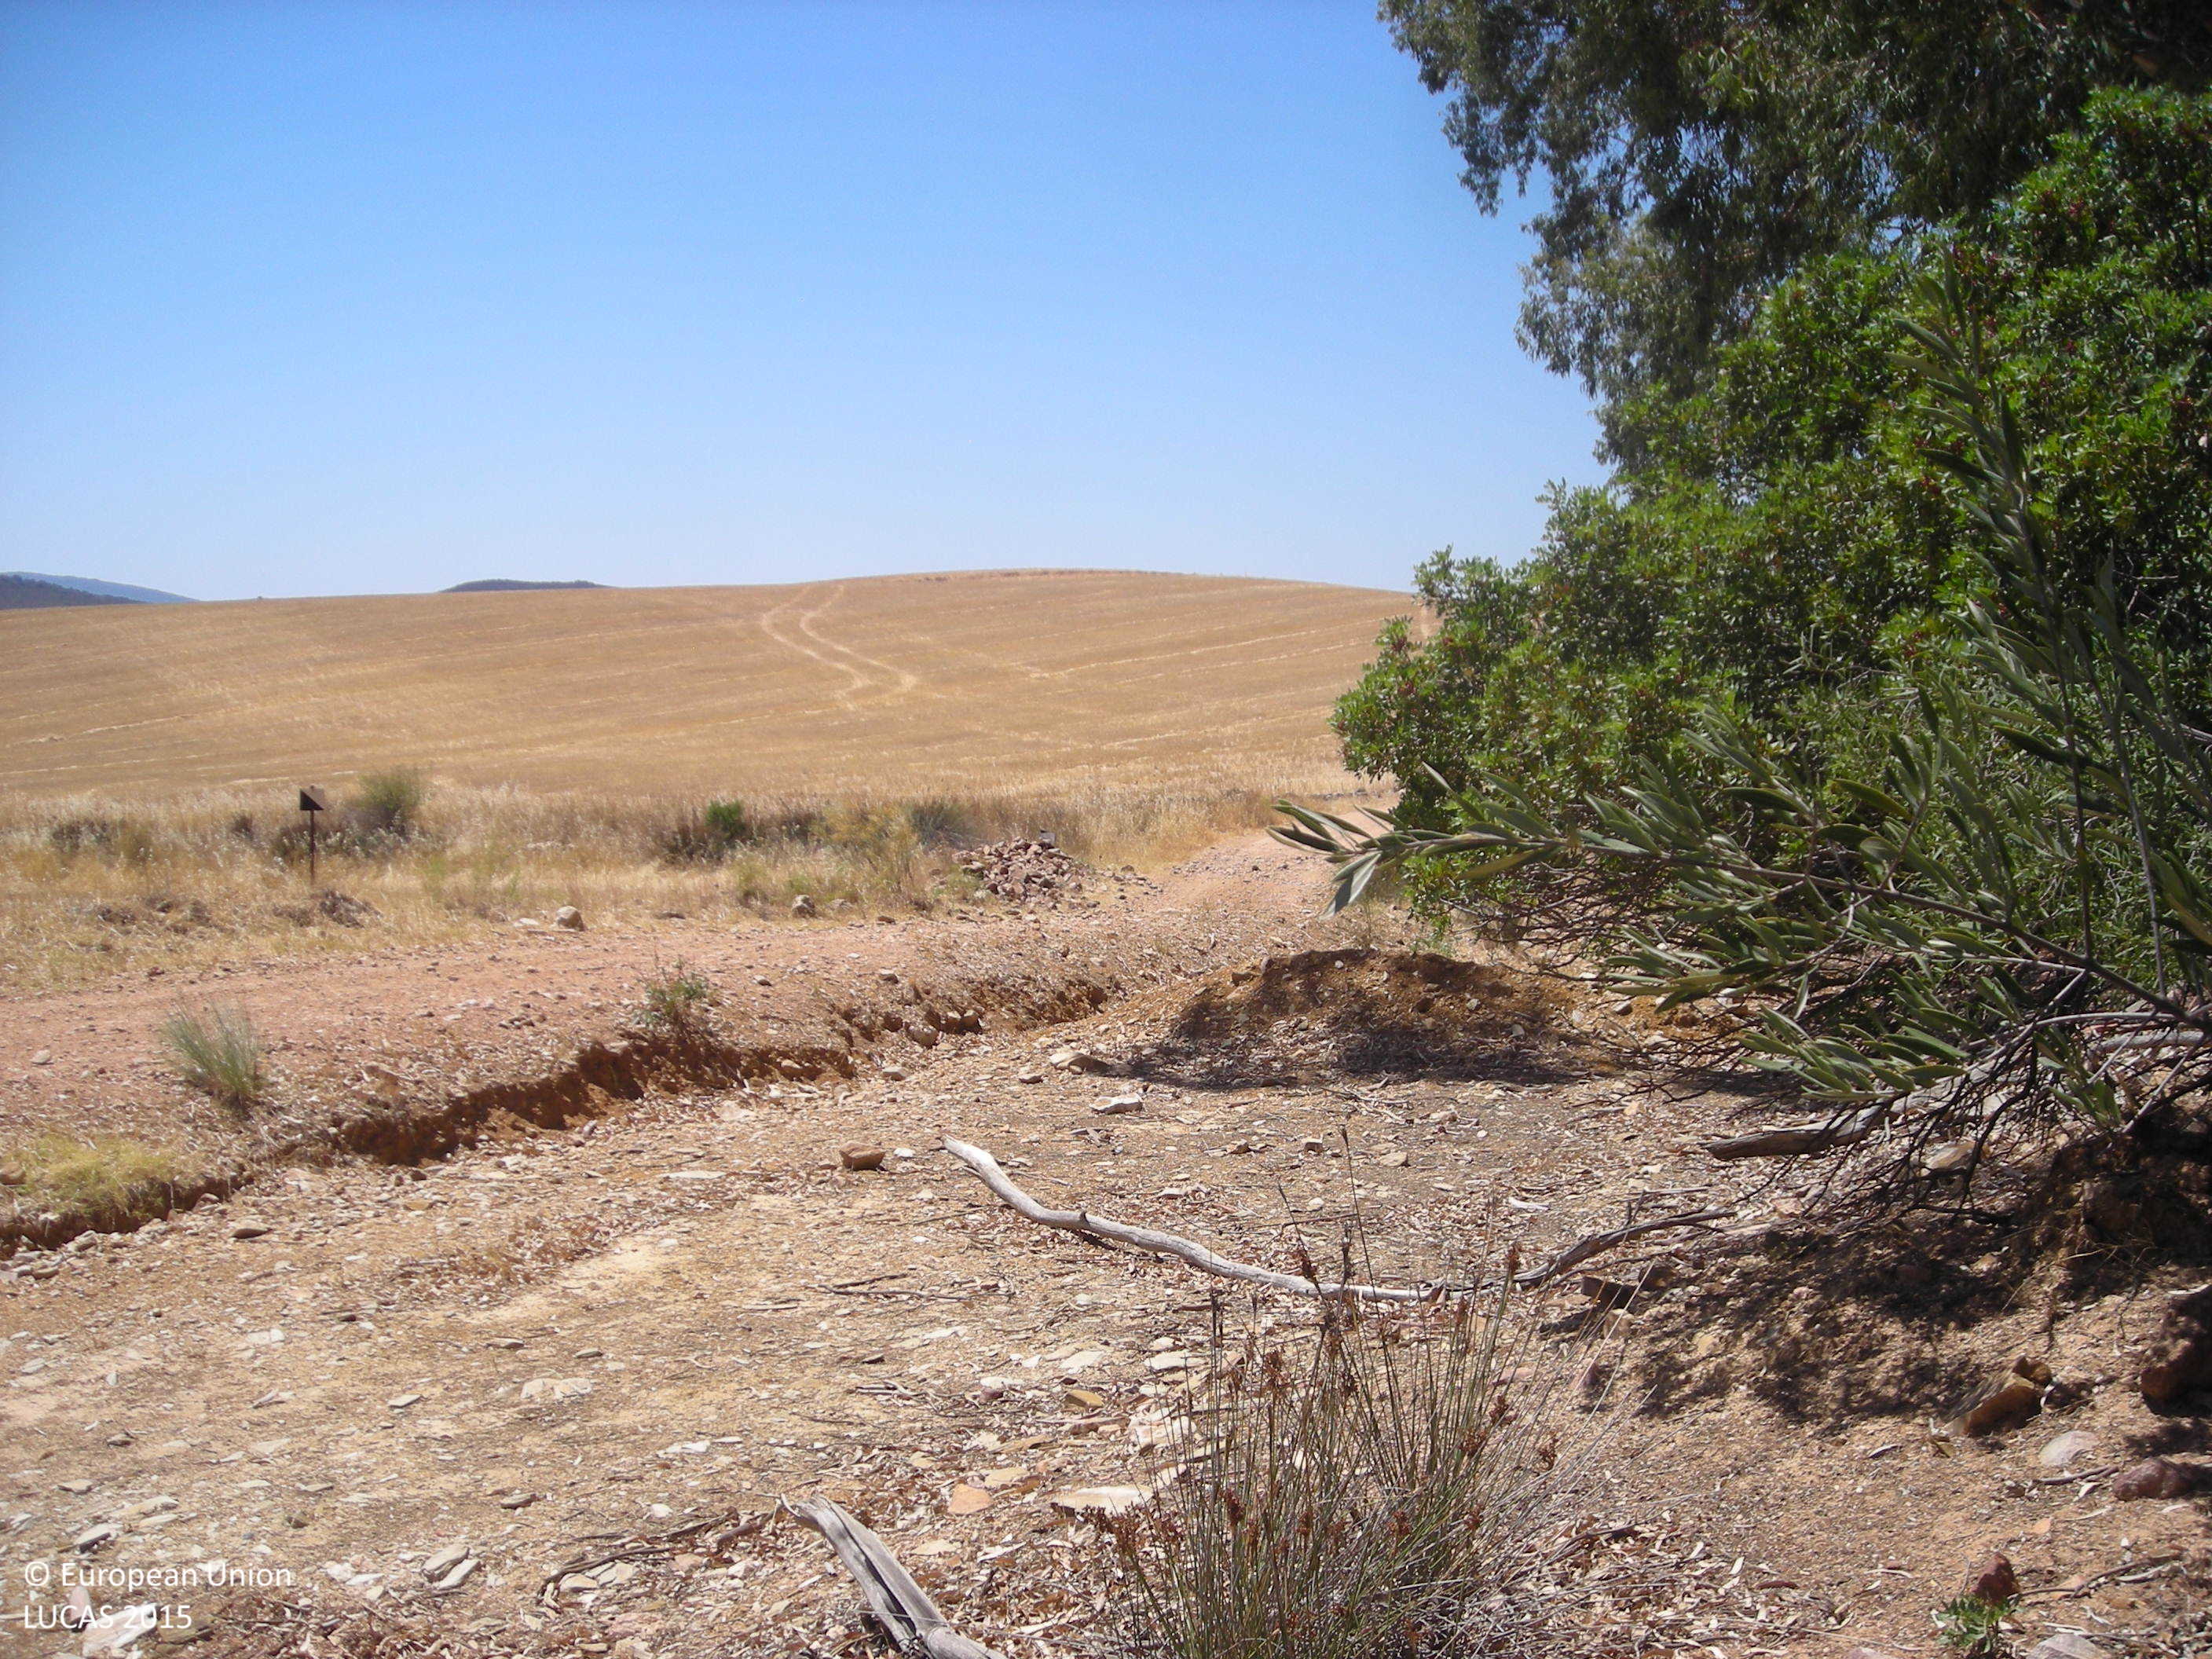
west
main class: Shrubland
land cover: Shrubland without tree cover
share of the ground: > 75 %
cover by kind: shrubs 100 %
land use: Semi-natural and natural areas not in use
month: July
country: ES
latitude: 38.7574
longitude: -5.7986
